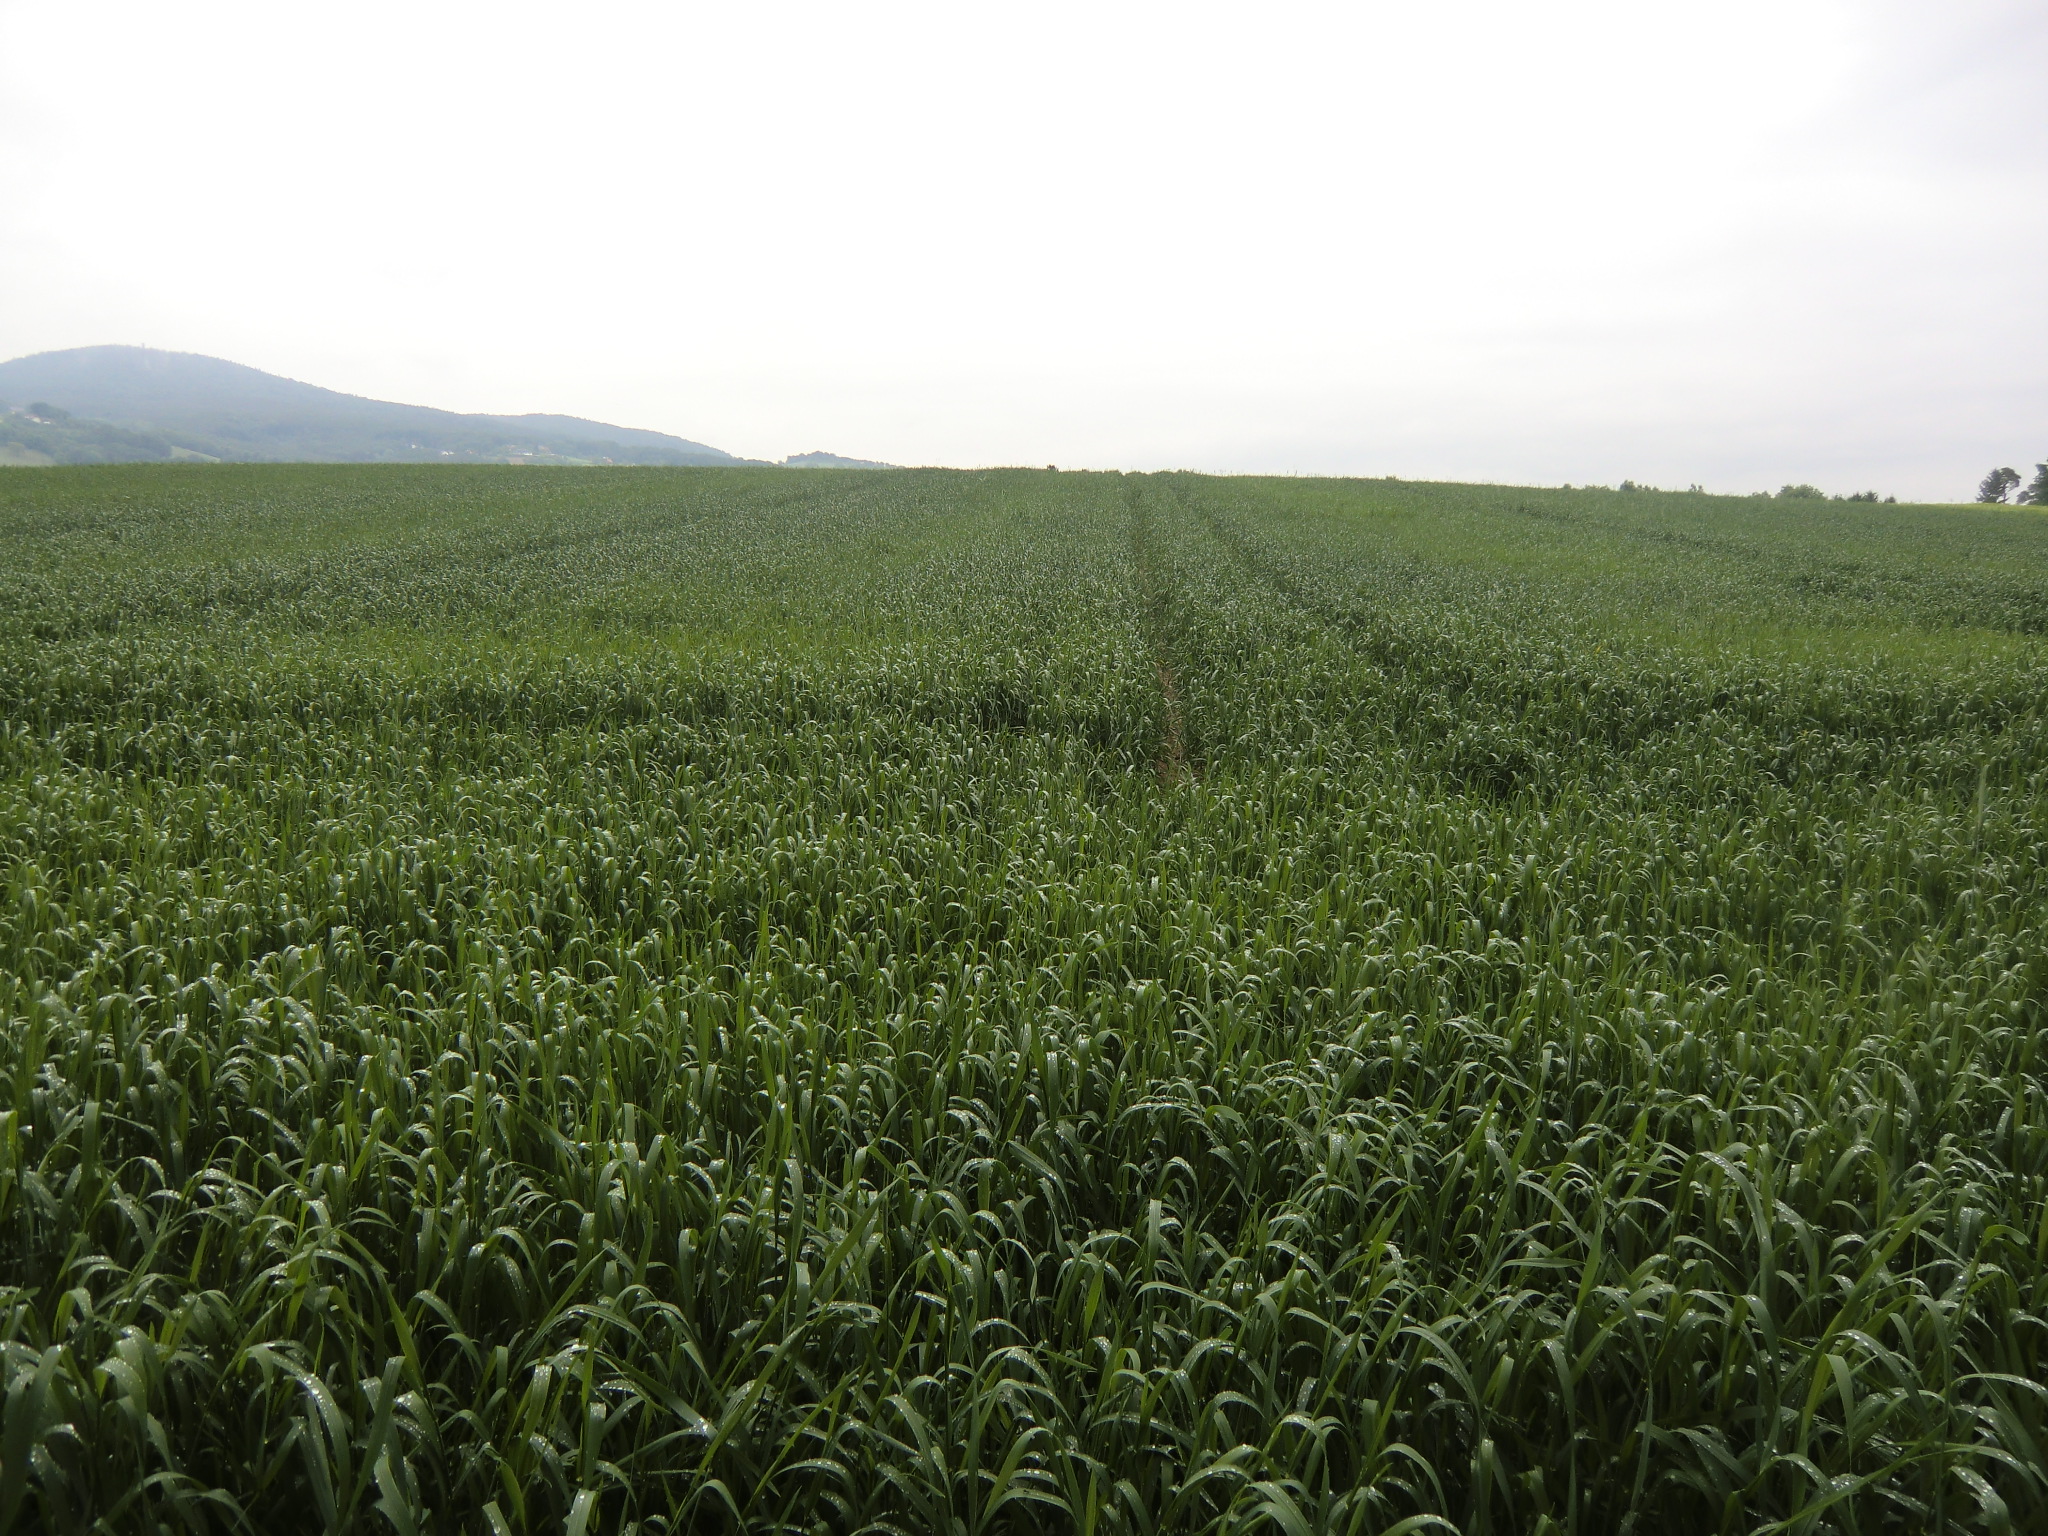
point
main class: Cropland
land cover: Common wheat
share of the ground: > 75 %
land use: Agriculture (excluding fallow land and kitchen gardens)
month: May
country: AT
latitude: 47.2696
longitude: 15.9362
